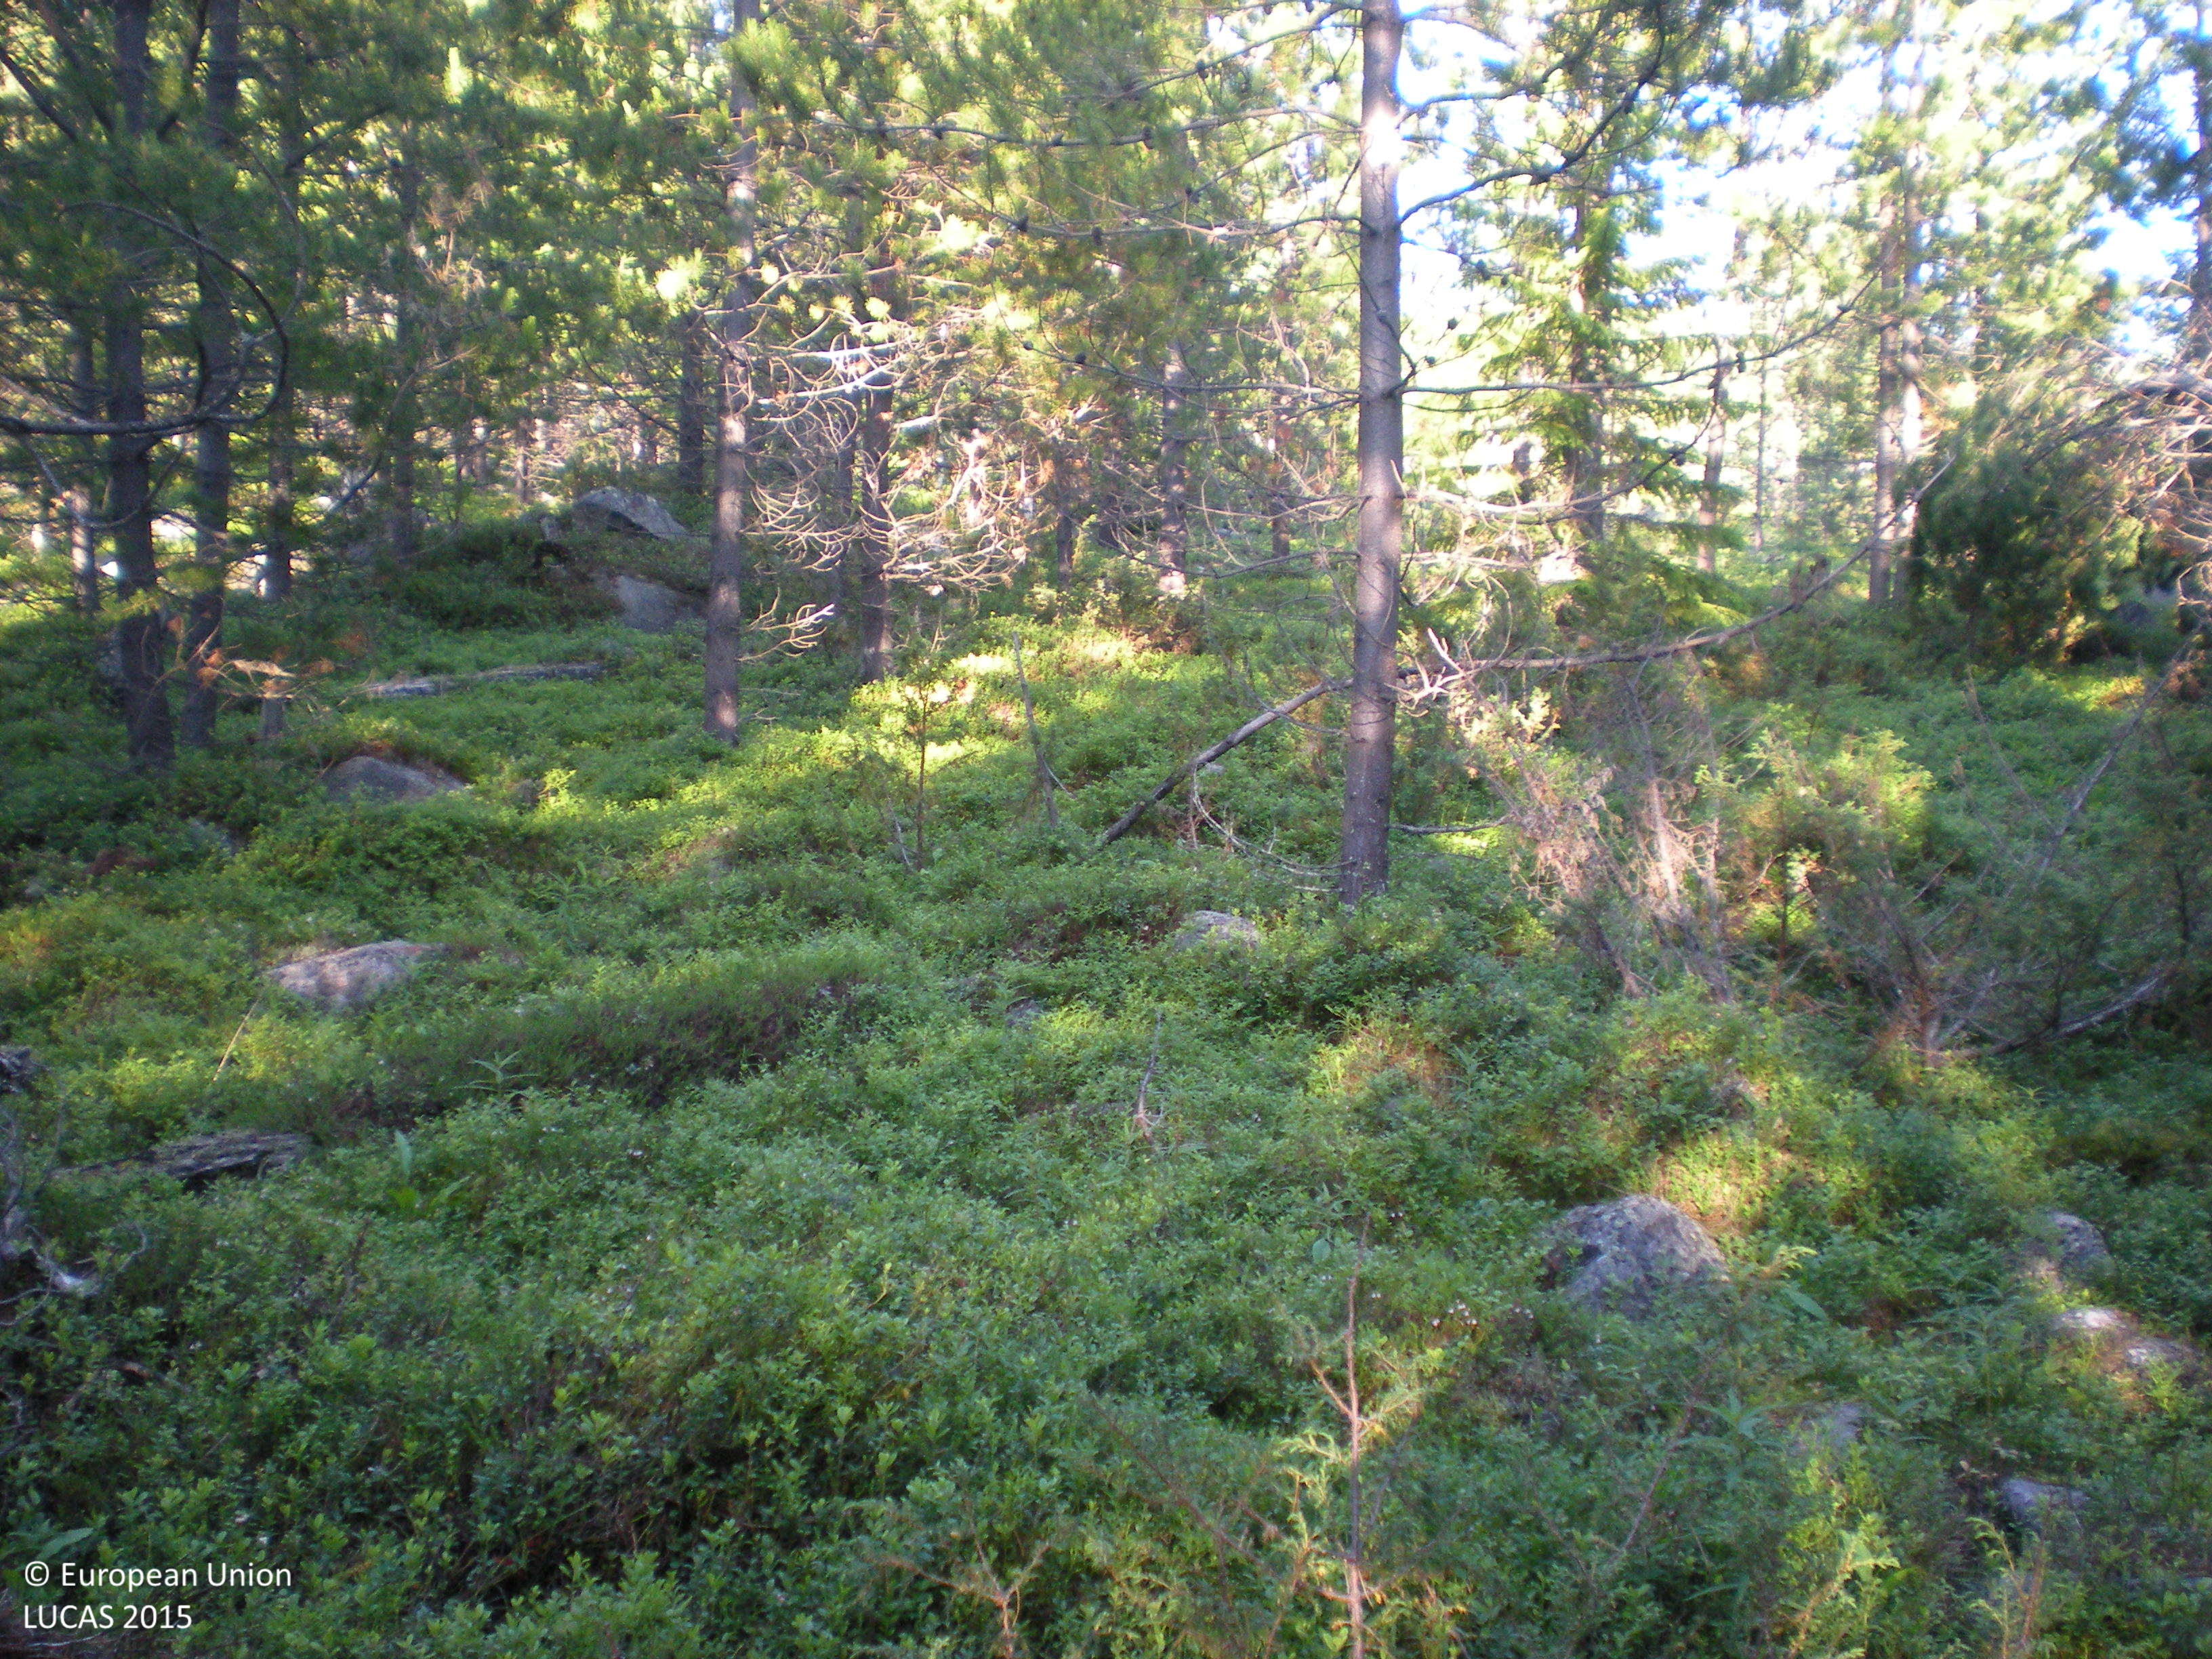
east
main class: Woodland
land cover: Pine dominated coniferous woodland
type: exotic forest
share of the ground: 50 - 75 %
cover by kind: coniferous forest trees 75 %, shrubs 20 %, consolidated bare surface 5 %
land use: Forestry
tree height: > 5 m
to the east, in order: Pine dominated coniferous woodland; Pine dominated mixed woodland
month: August
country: SE
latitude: 66.2672
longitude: 18.0360
